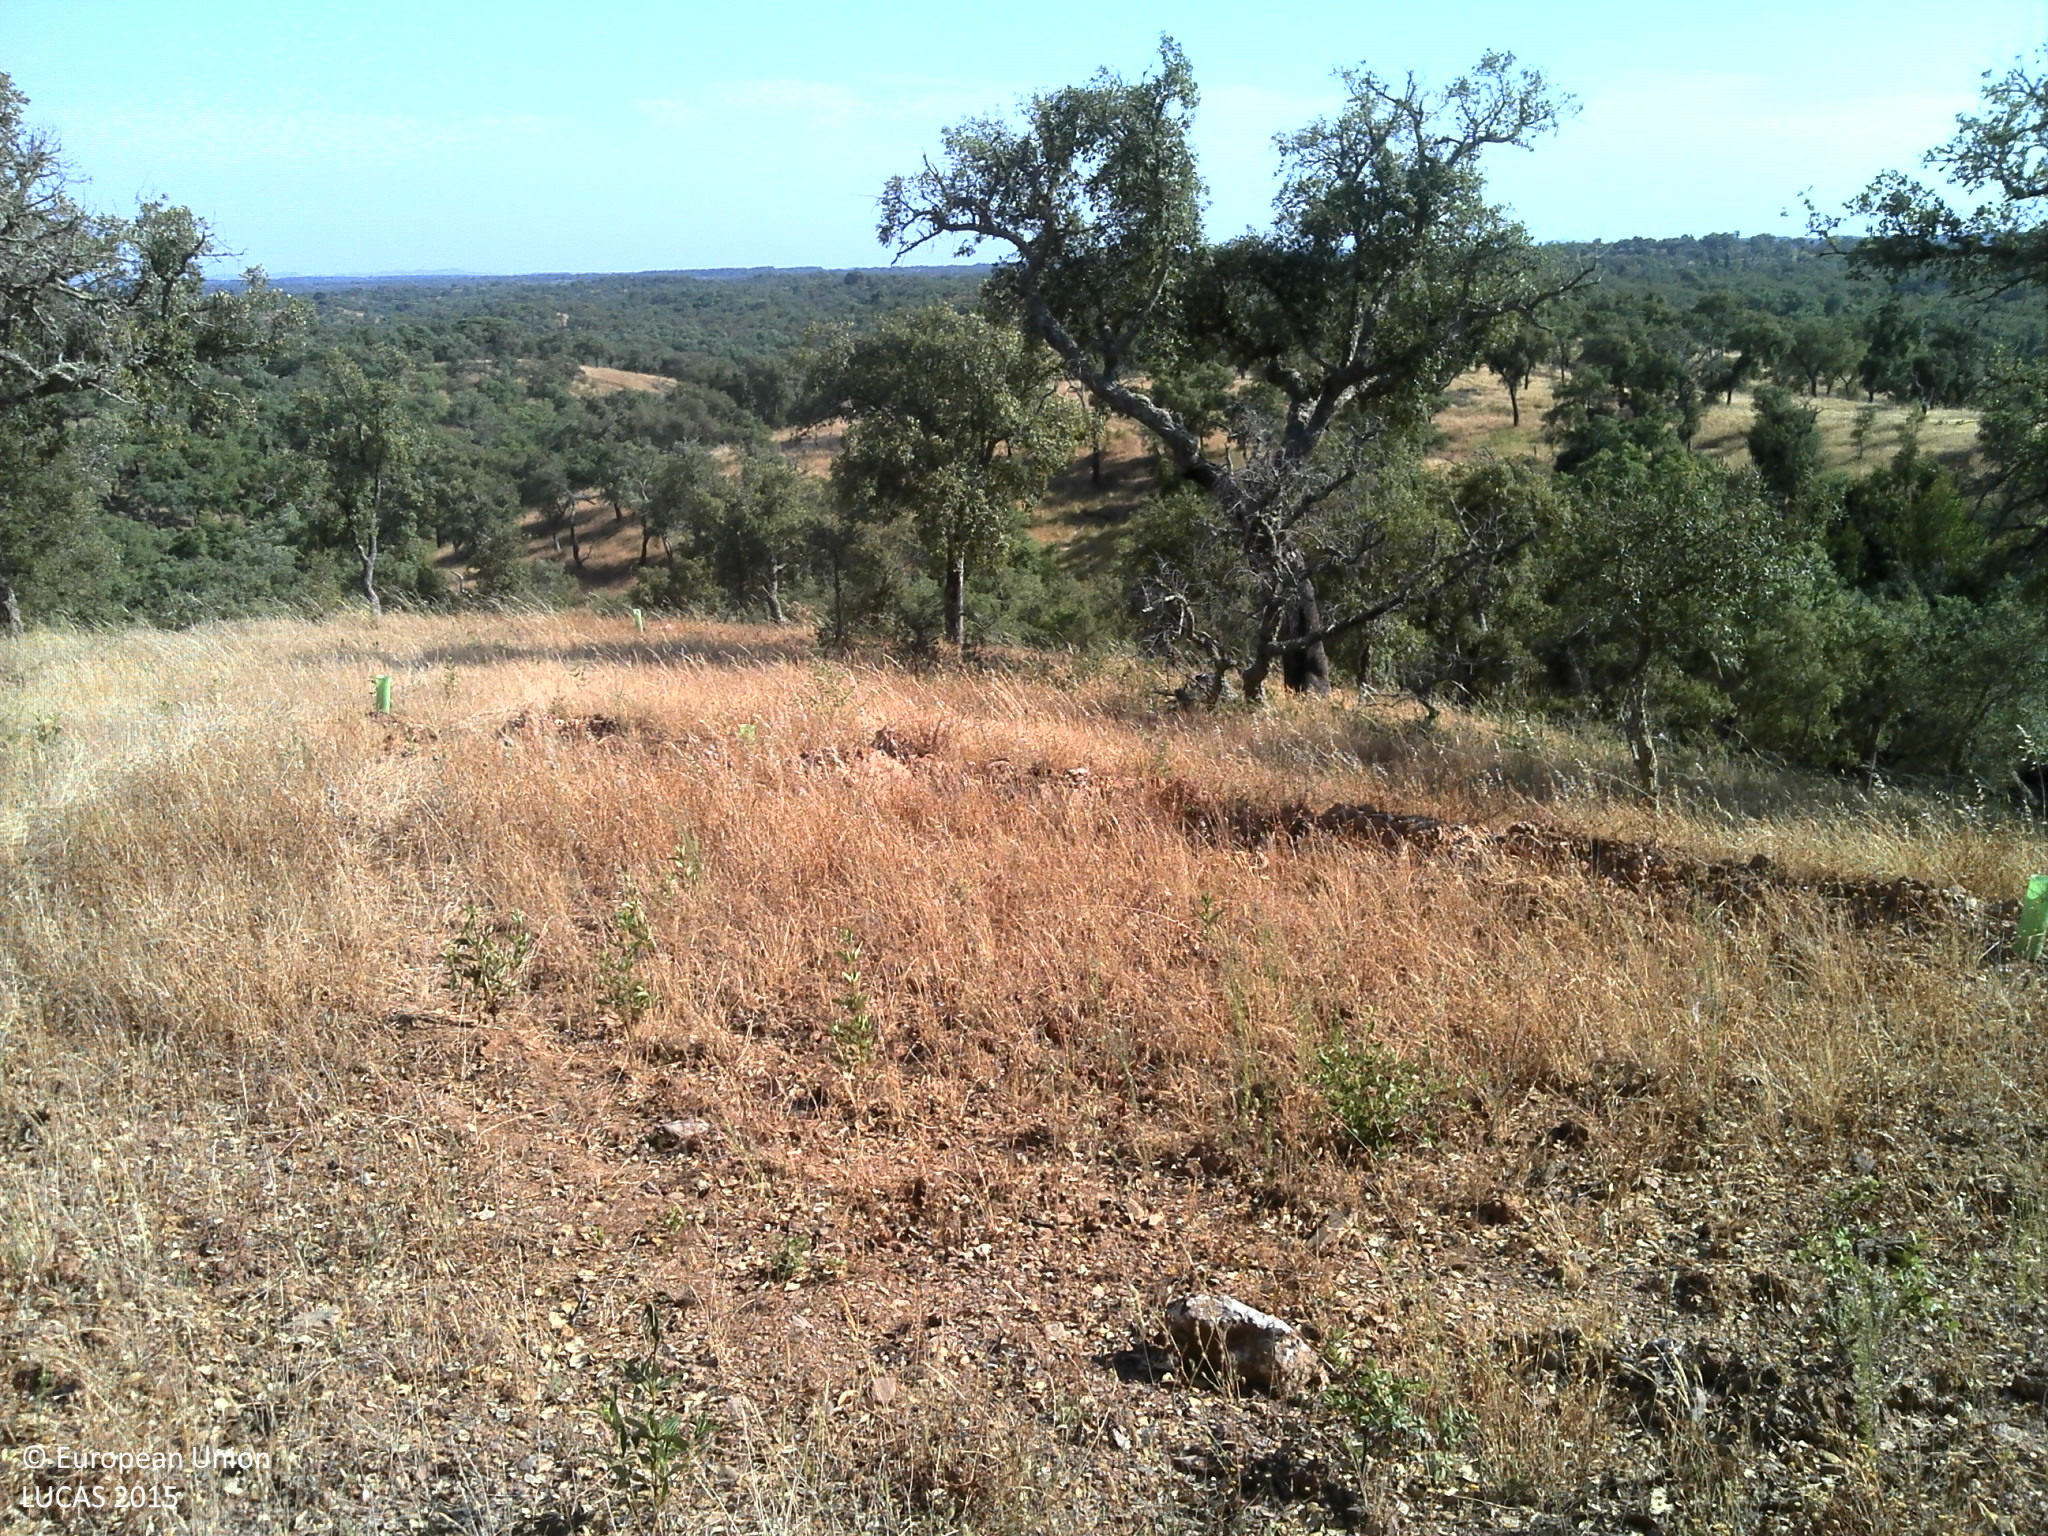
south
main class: Woodland
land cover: Broadleaved woodland
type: broadleaved evergreen forest
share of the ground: 25 - 50 %
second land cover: Grassland without tree/shrub cover
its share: 25 - 50 %
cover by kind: herbaceous plants 50 %, broadleaved forest trees 30 %, unconsolidated bare surface 20 %
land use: Forestry
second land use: Agriculture (excluding fallow land and kitchen gardens)
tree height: > 5 m
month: May
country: PT
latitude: 37.9862
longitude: -8.6160
